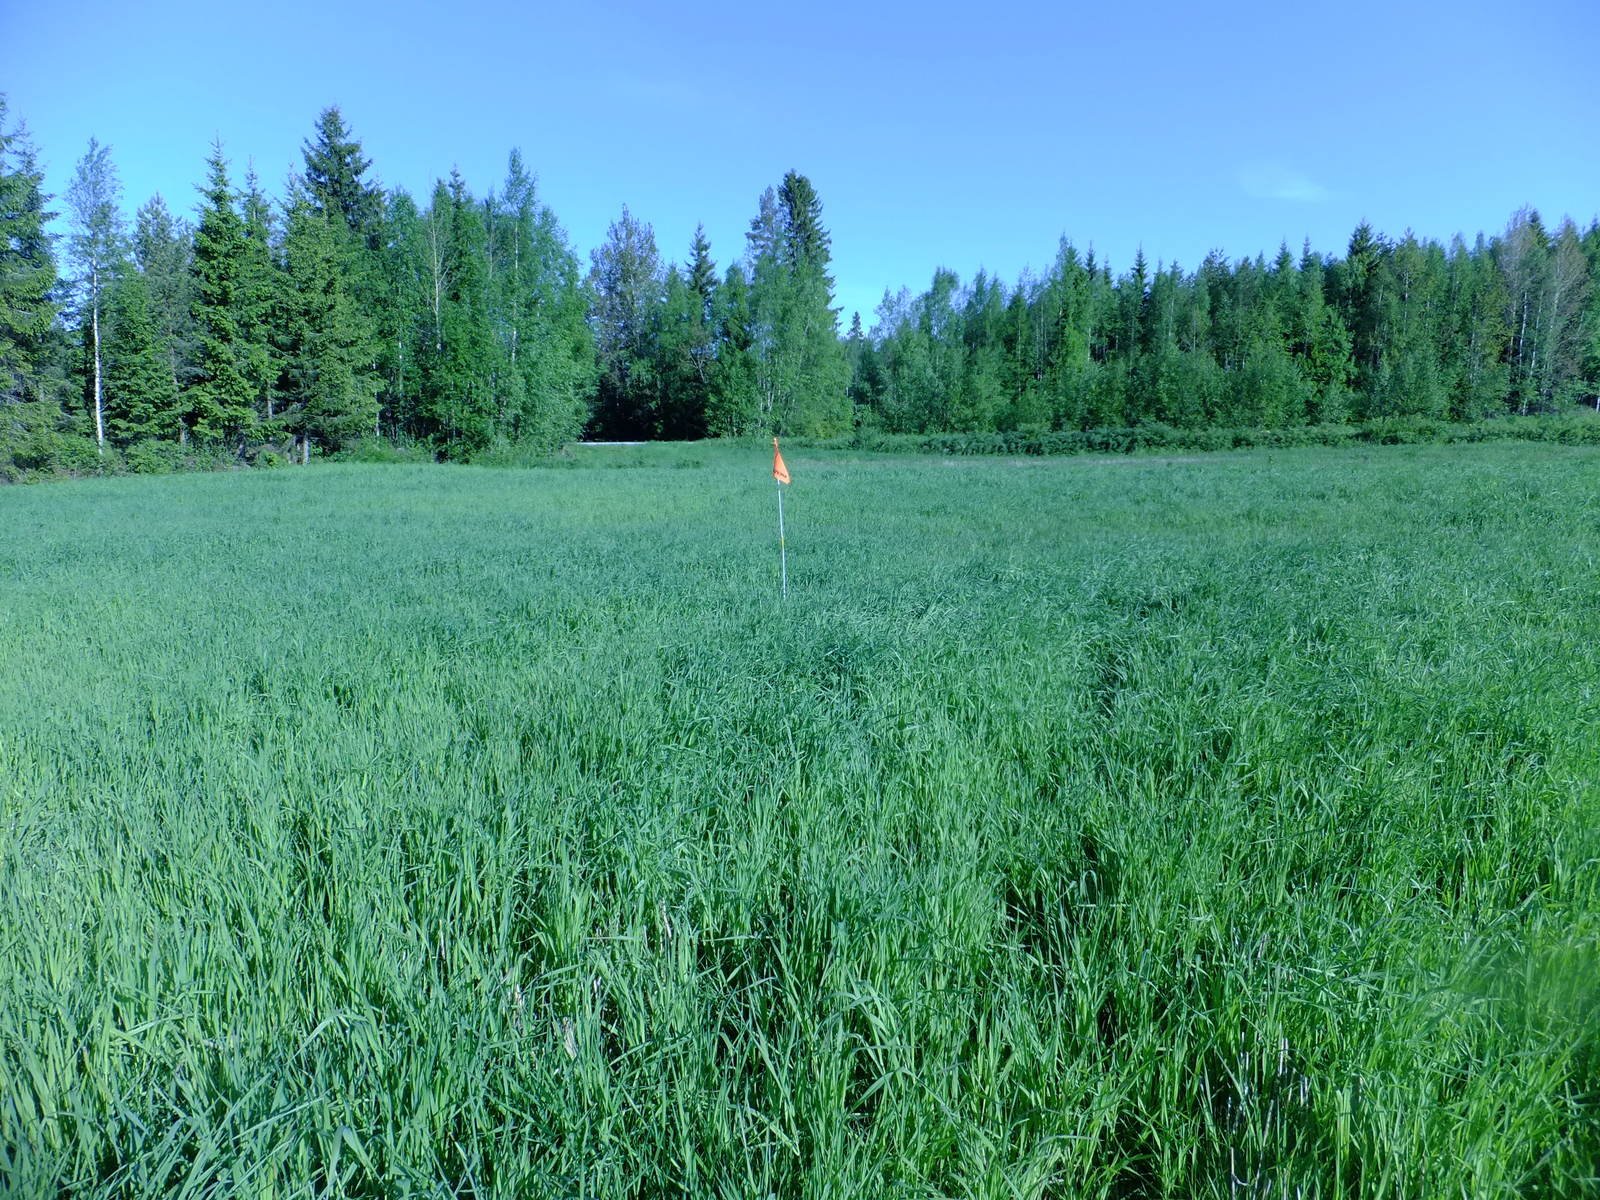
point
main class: Cropland
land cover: Temporary grasslands
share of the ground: > 75 %
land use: Agriculture (excluding fallow land and kitchen gardens)
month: June
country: FI
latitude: 63.4520
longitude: 22.6233
